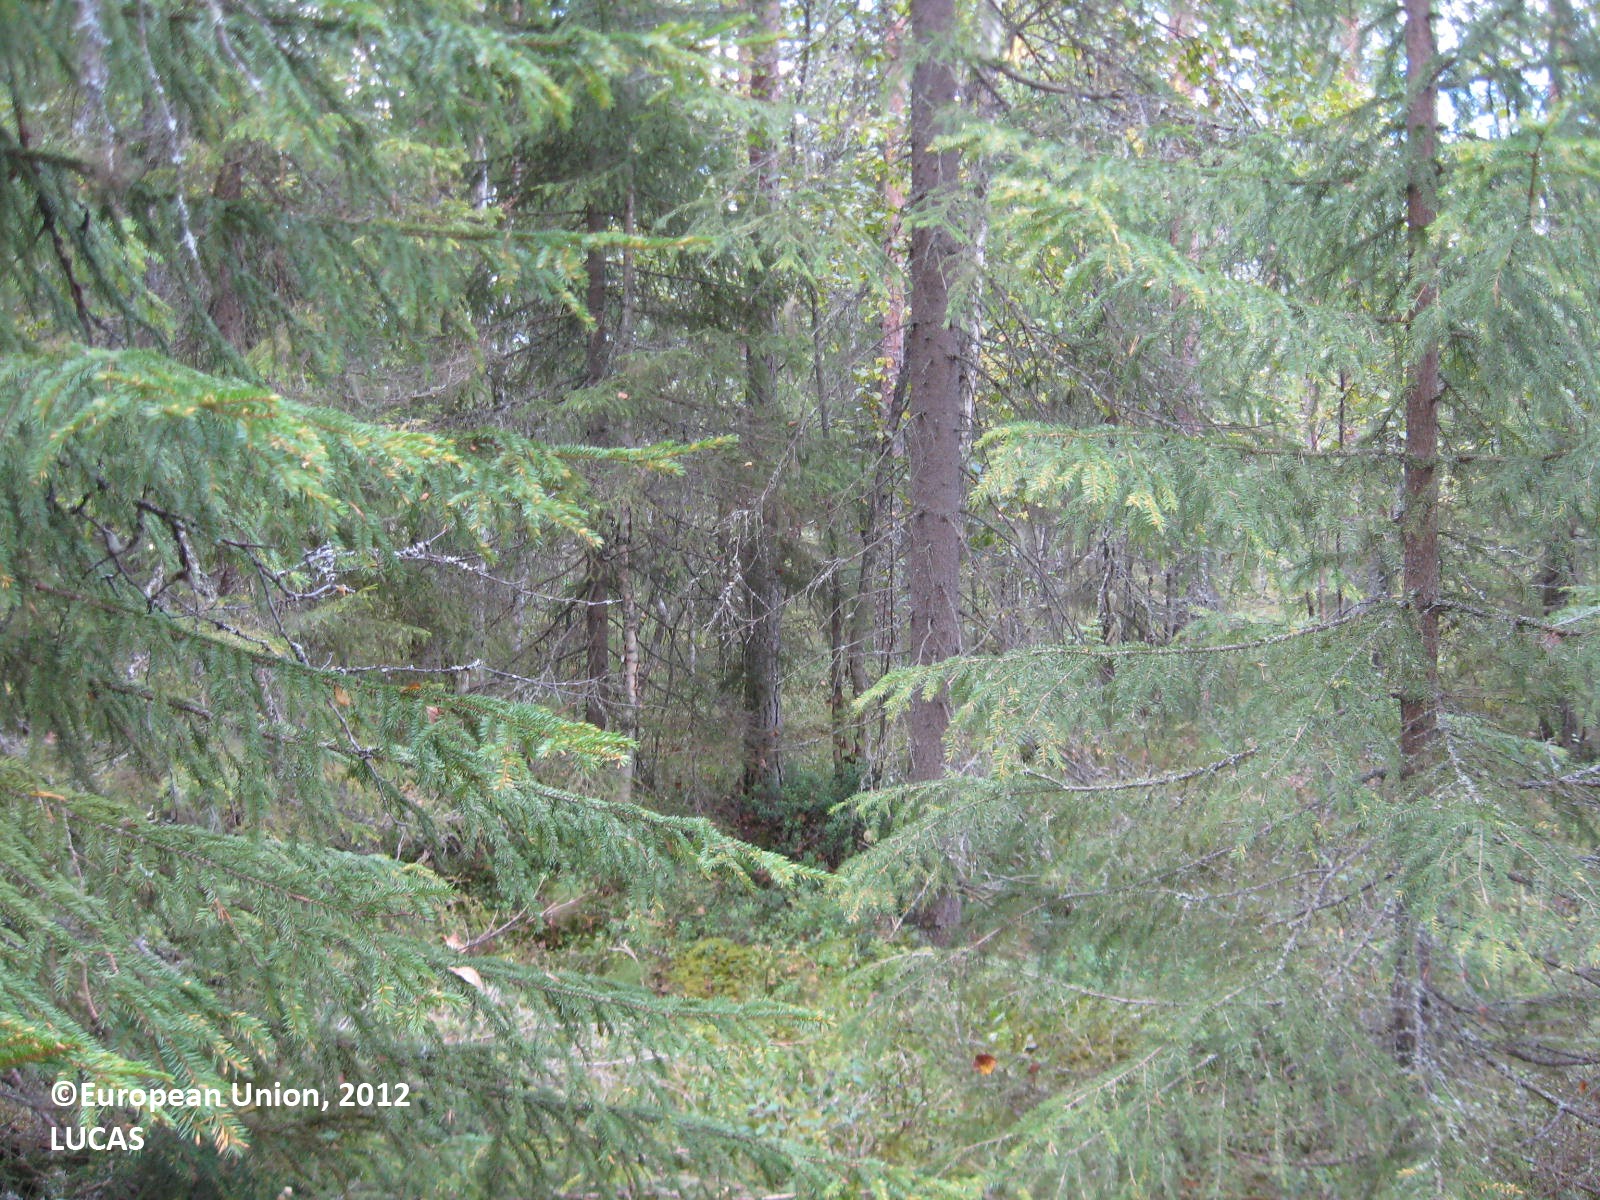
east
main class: Woodland
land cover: Pine dominated mixed woodland
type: boreal forest
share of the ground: 50 - 75 %
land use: Forestry
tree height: > 5 m
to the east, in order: Pine dominated mixed woodland; Ditches and canals; Other coniferous woodland; Other mixed woodland; Other coniferous woodland
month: August
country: FI
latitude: 63.6409
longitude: 29.4623
